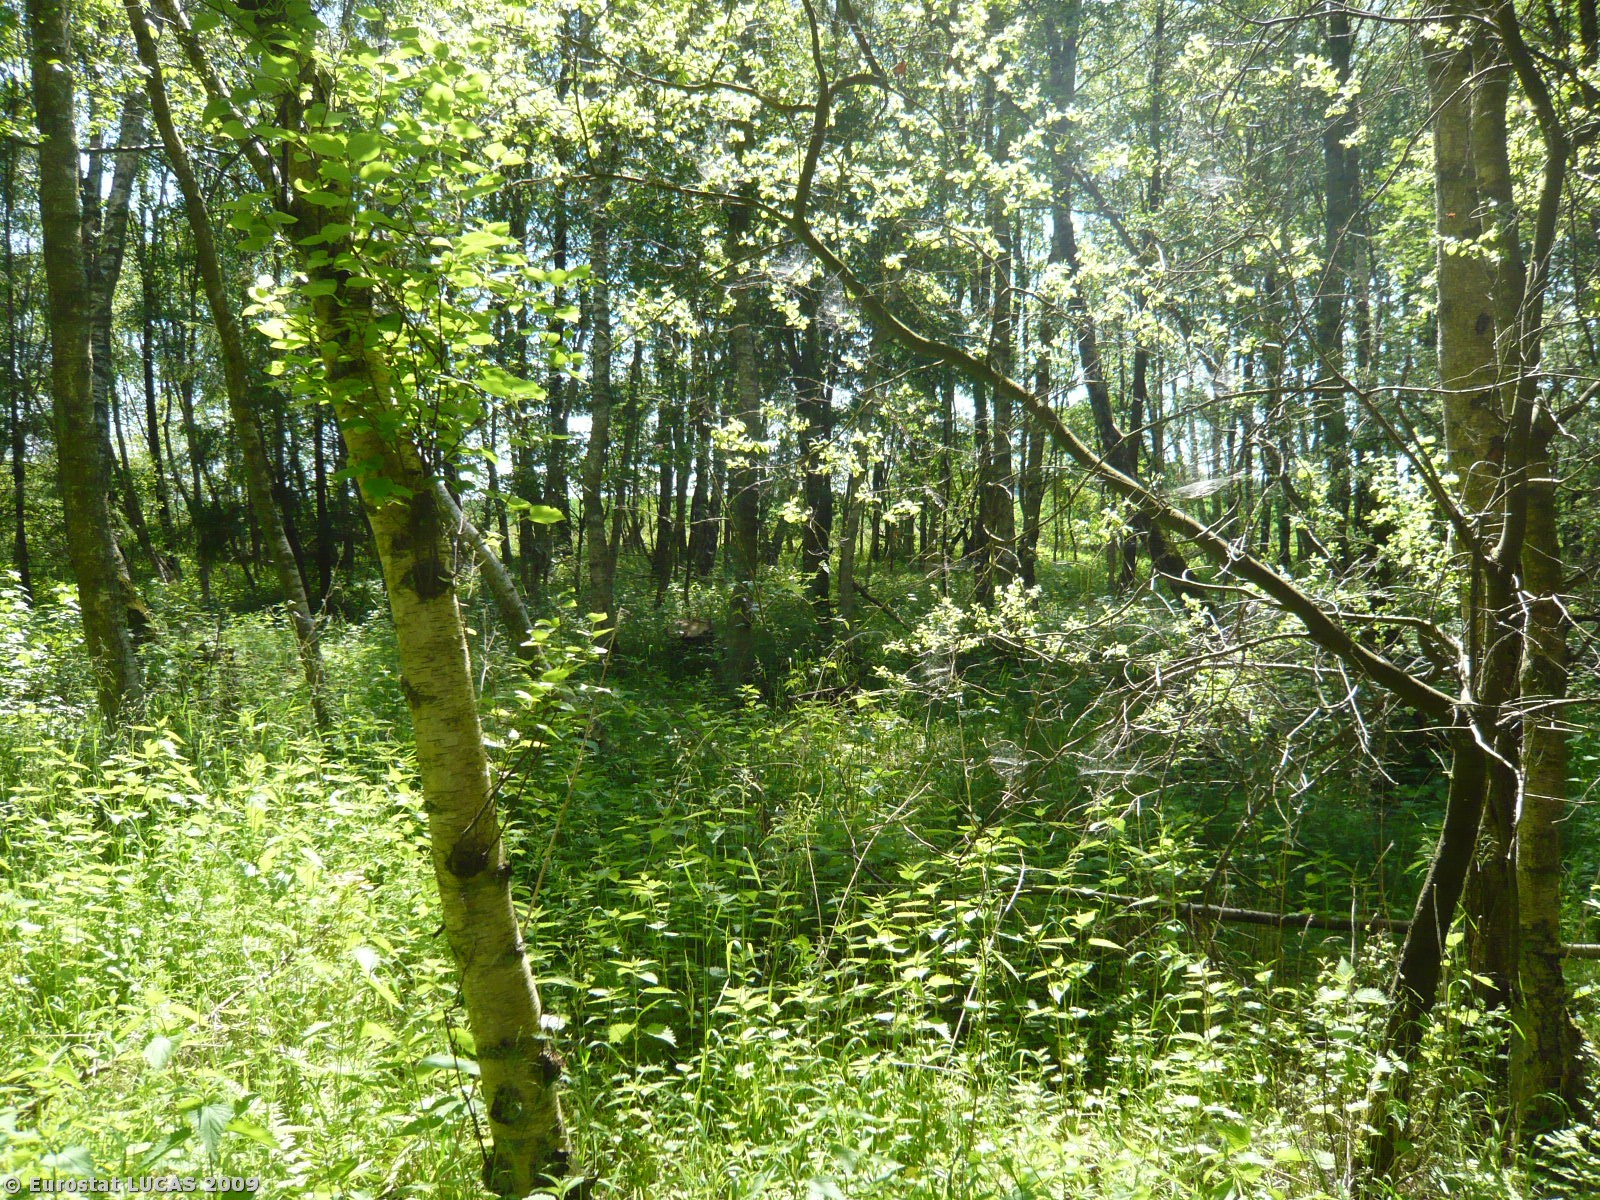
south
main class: Woodland
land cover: Broadleaved woodland
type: non-riverine alder, birch or aspen forest
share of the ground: > 75 %
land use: Forestry
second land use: Amenities, museums, leisure
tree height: > 5 m
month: May
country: DK
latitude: 55.3124
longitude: 11.7790
